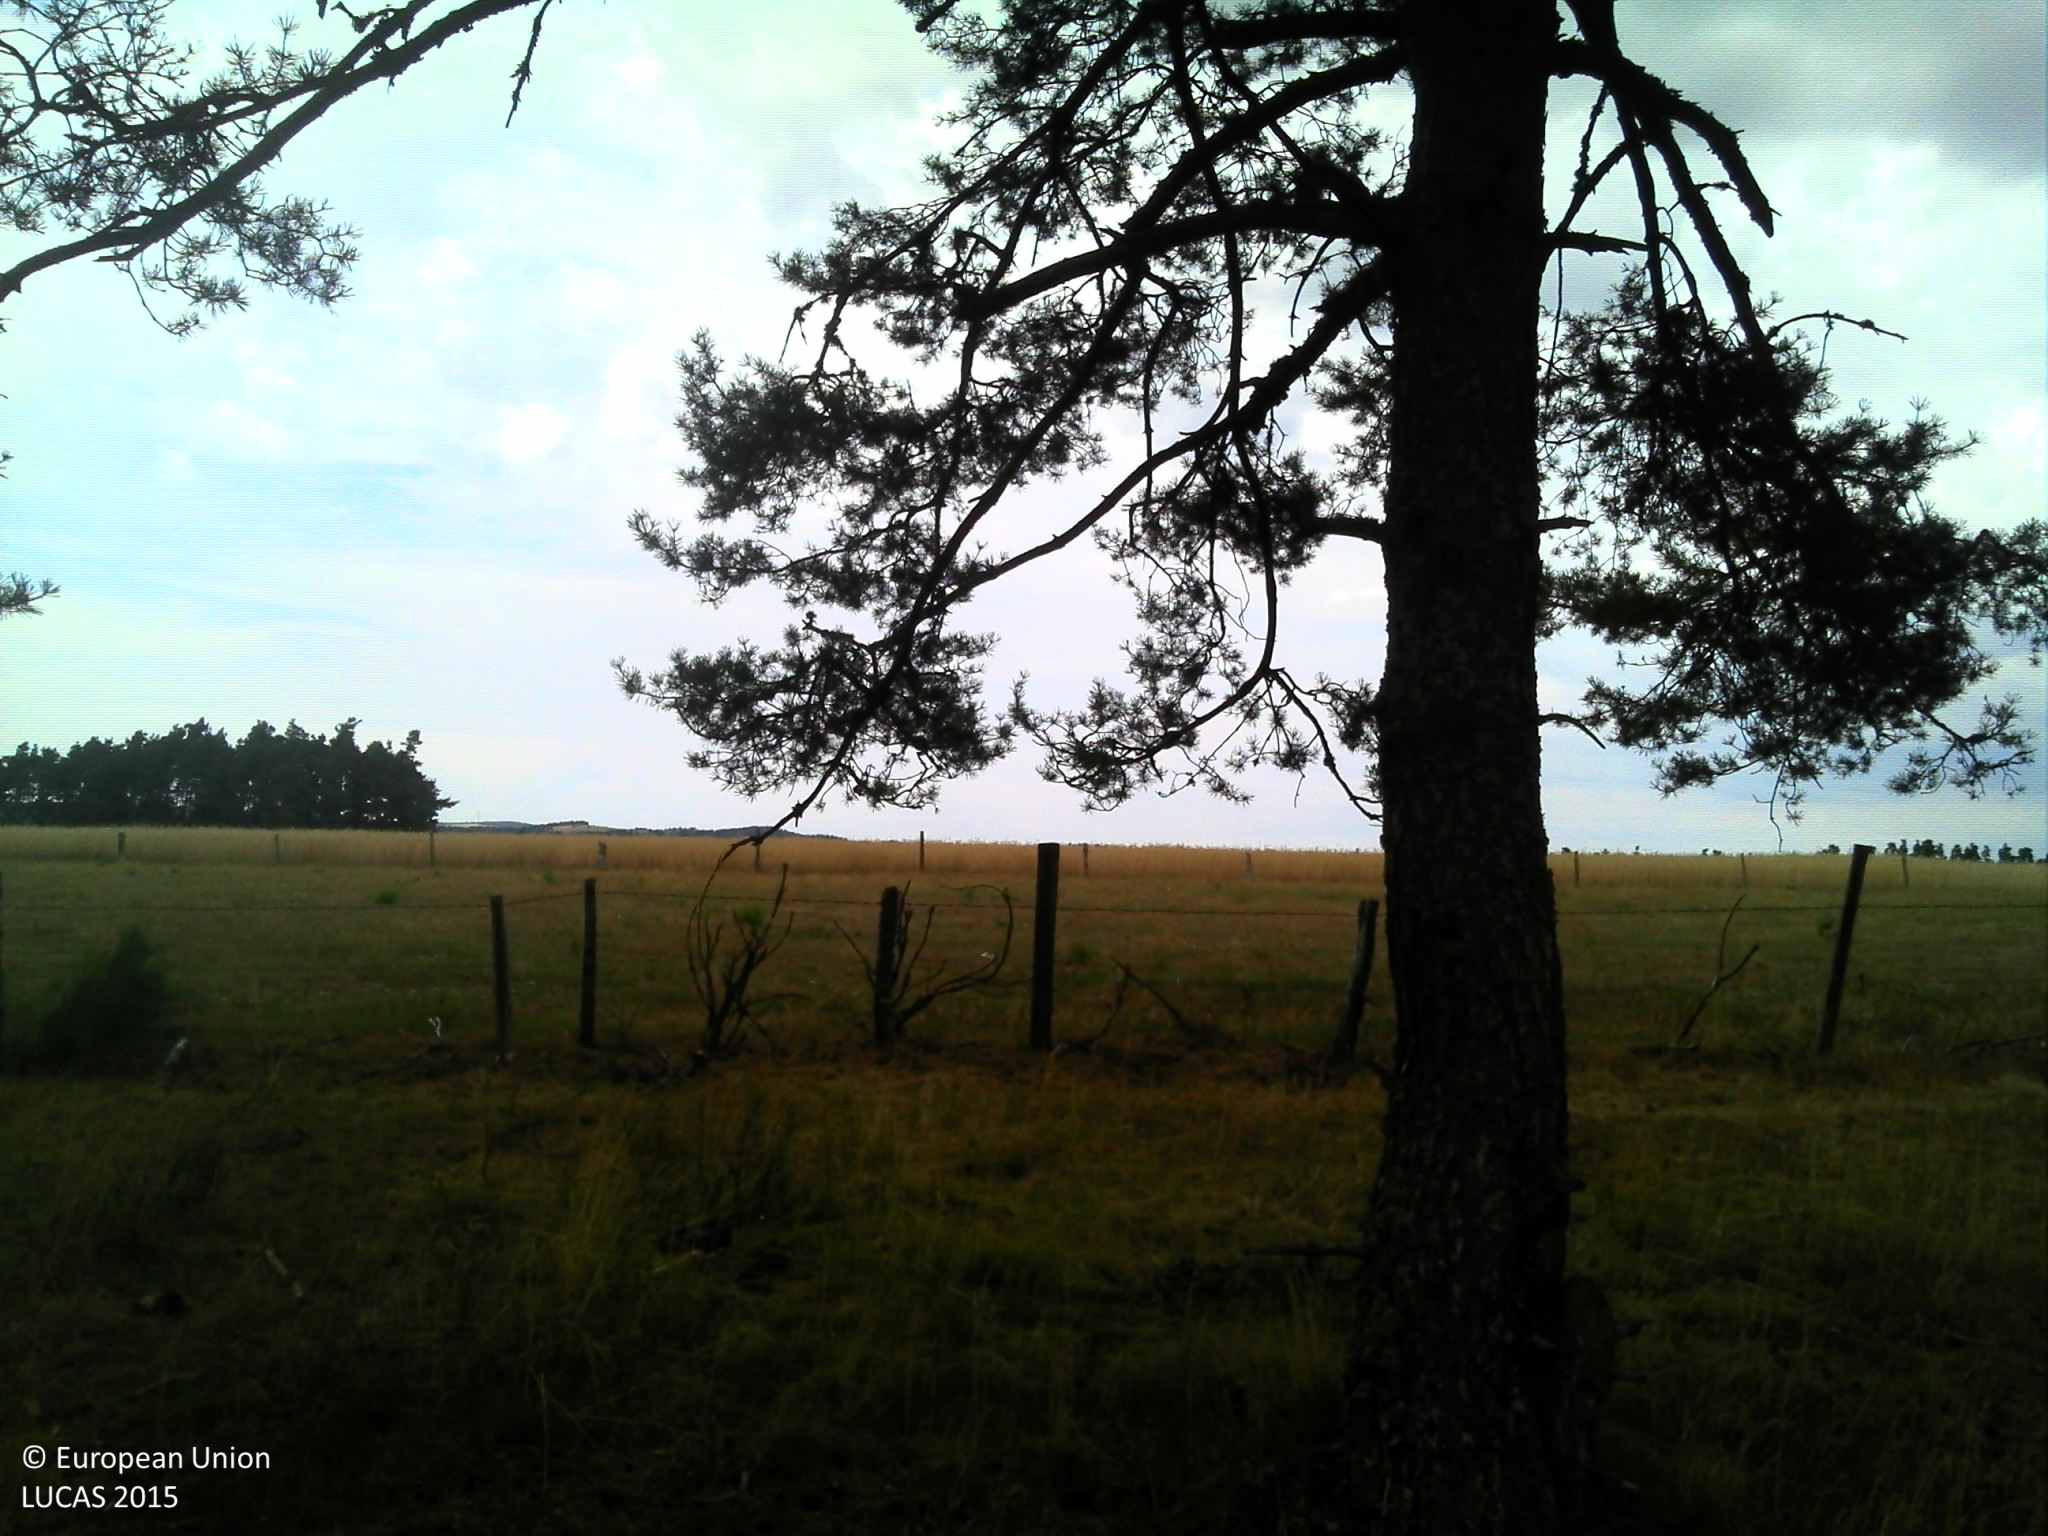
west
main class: Woodland
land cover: Pine dominated coniferous woodland
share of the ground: > 75 %
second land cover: Grassland without tree/shrub cover
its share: > 75 %
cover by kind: coniferous forest trees 95 %, broadleaved forest trees 5 %
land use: Forestry
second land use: Agriculture (excluding fallow land and kitchen gardens)
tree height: > 5 m
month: July
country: FR
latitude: 44.6933
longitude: 3.2782
